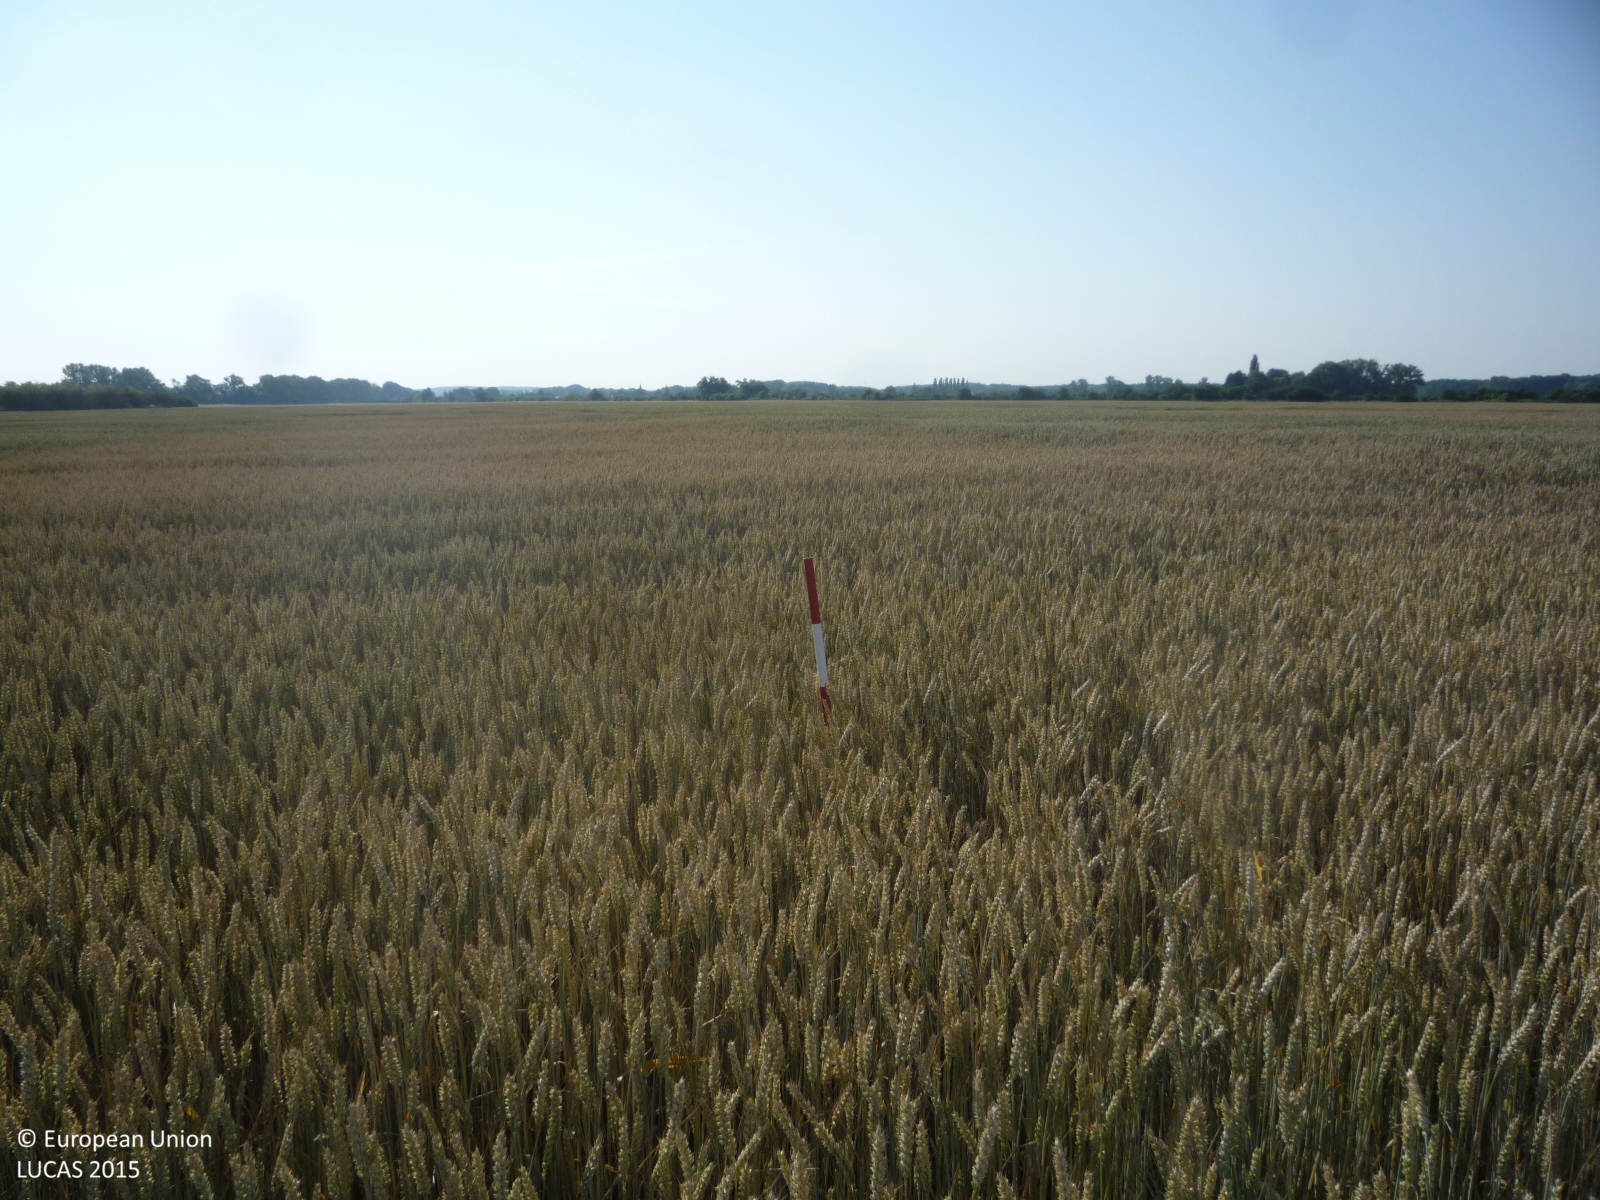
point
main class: Cropland
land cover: Common wheat
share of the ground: > 75 %
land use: Agriculture (excluding fallow land and kitchen gardens)
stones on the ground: < 10 %
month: July
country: CZ
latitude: 50.1380
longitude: 15.1940
